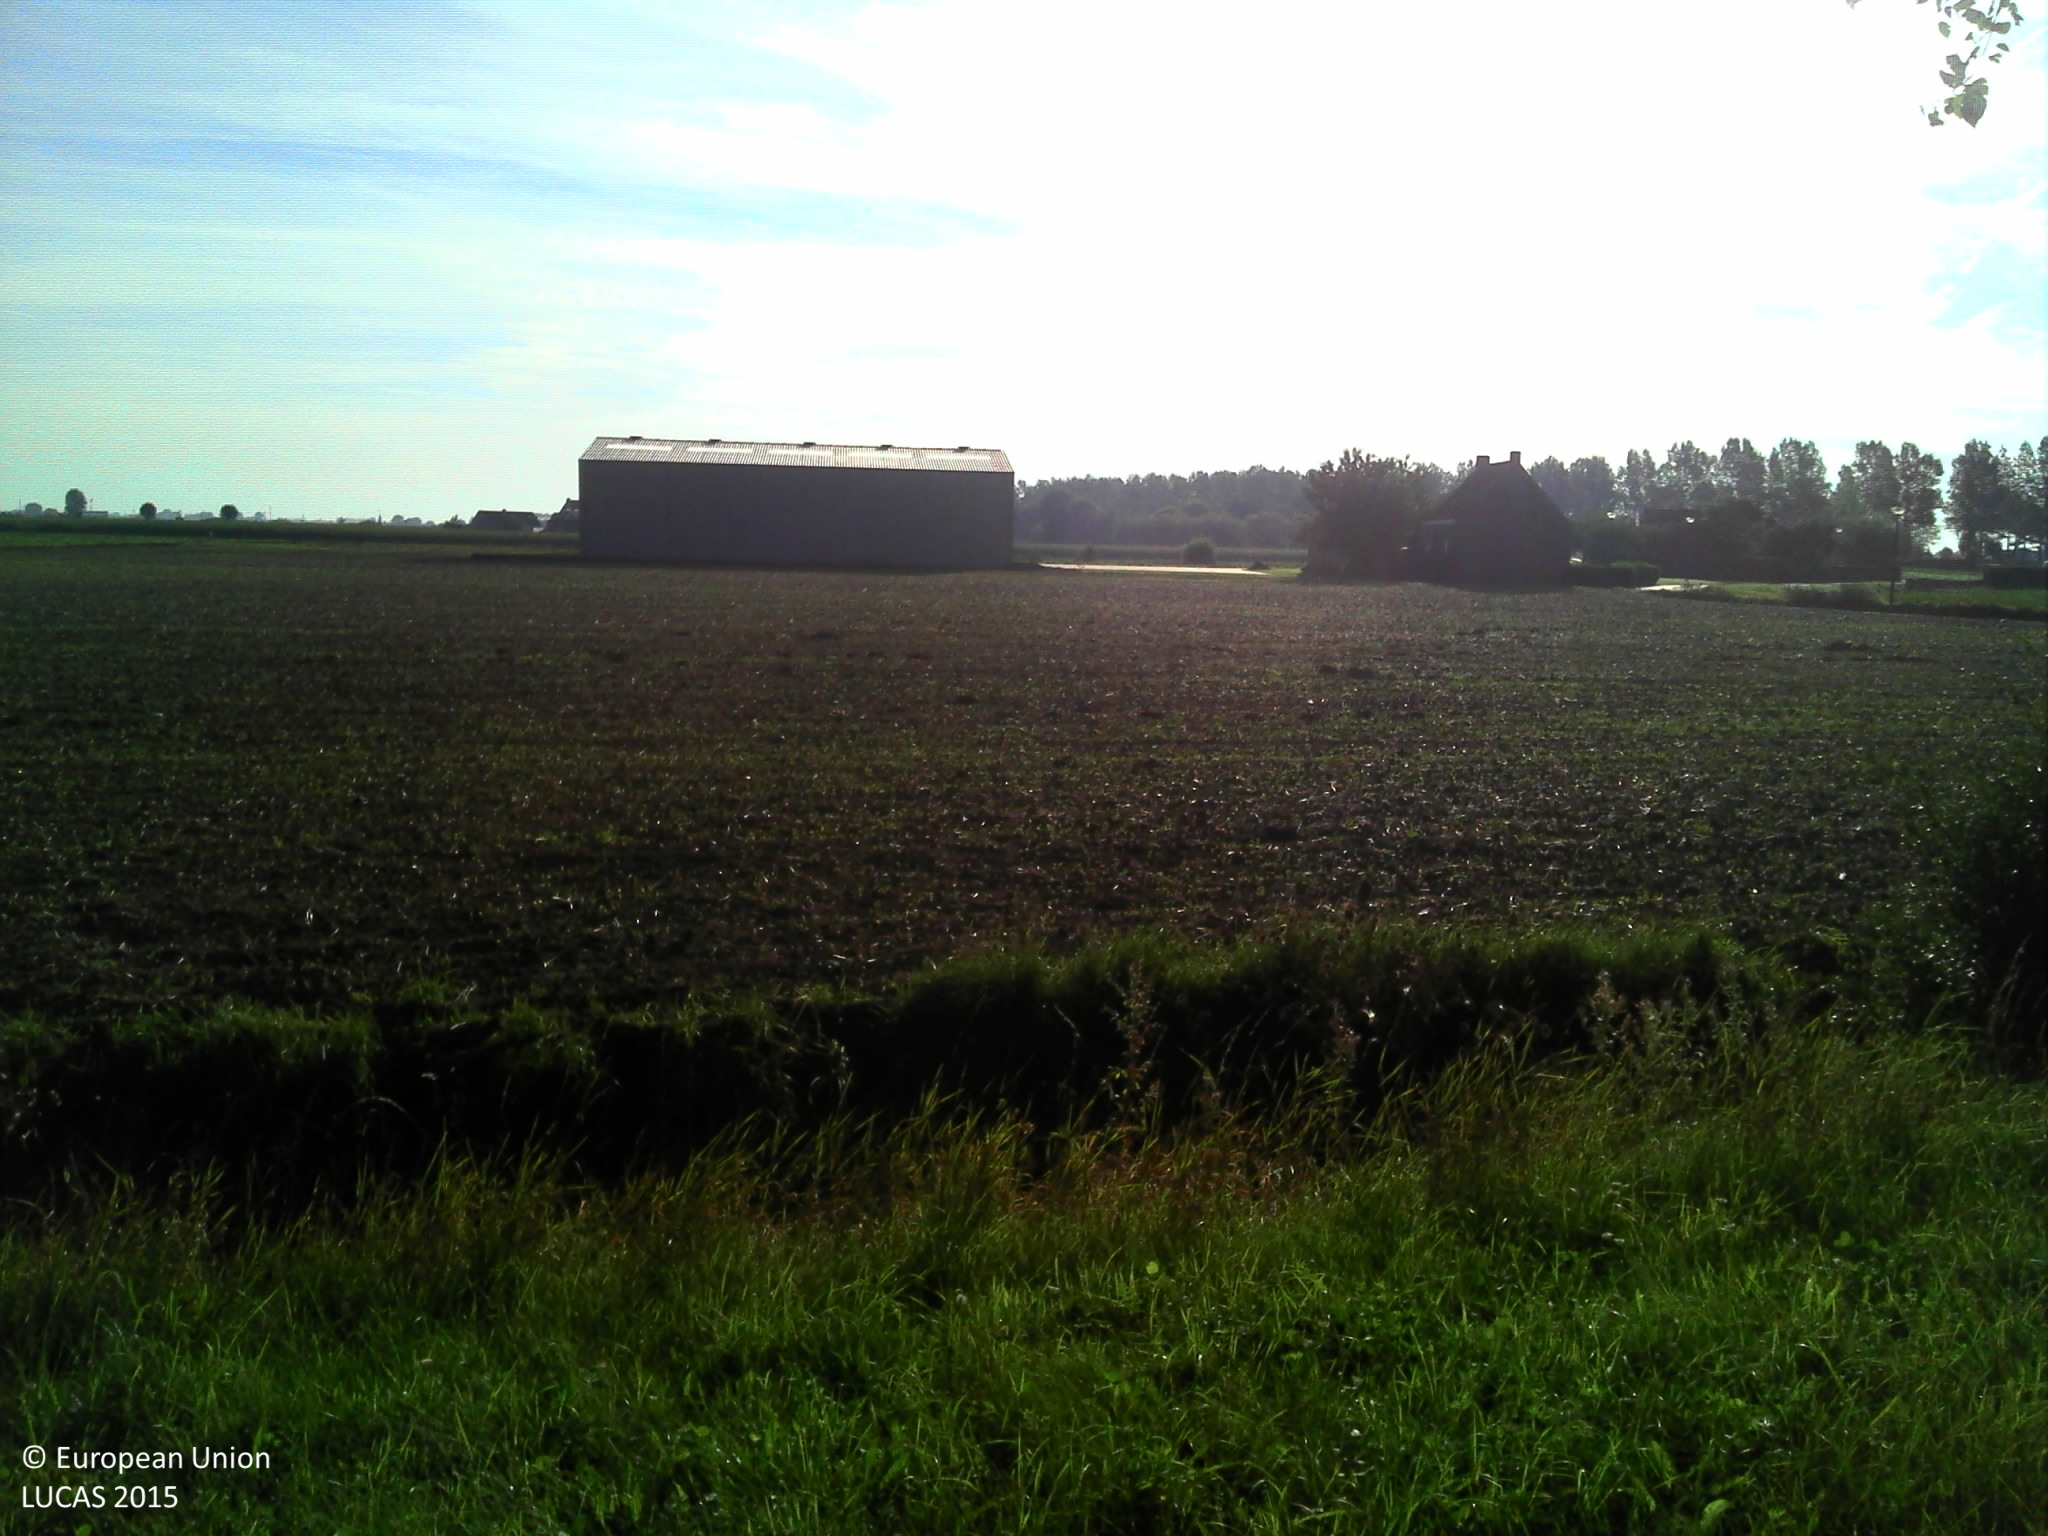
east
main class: Woodland
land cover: Broadleaved woodland
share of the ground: > 75 %
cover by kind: broadleaved forest trees 80 %, herbaceous plants 20 %
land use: Road transport
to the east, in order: Grass margins; Paved roads, cycling and walking lanes; Broadleaved woodland; Ditches and canals; Common wheat; Artificial constructions in urban areas; Common wheat; Grass margins; Ditches and canals; Grass margins; Sugar beet
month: September
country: BE
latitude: 51.1050
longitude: 2.6901
